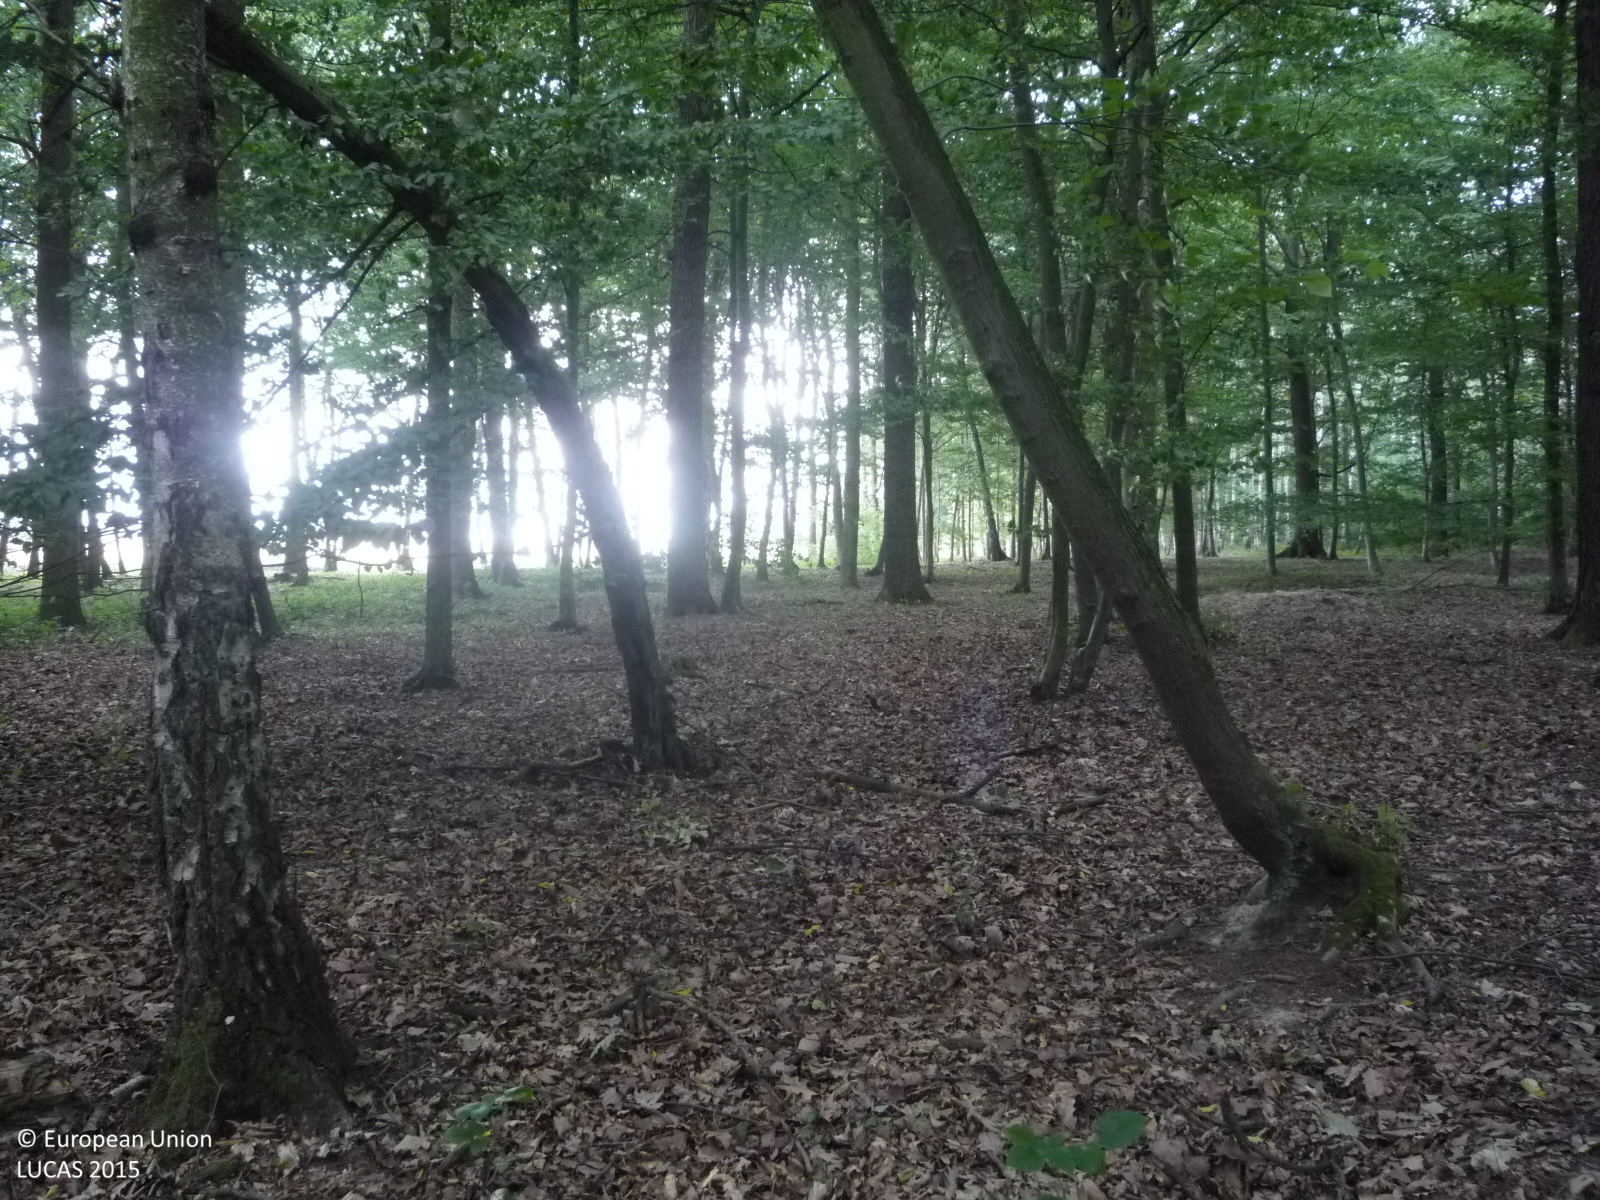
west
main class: Woodland
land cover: Broadleaved woodland
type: mesophytic deciduous forest
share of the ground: > 75 %
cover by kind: broadleaved forest trees 90 %, unconsolidated bare surface 10 %
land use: Forestry
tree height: > 5 m
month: July
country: CZ
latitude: 50.2781
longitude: 15.6597
